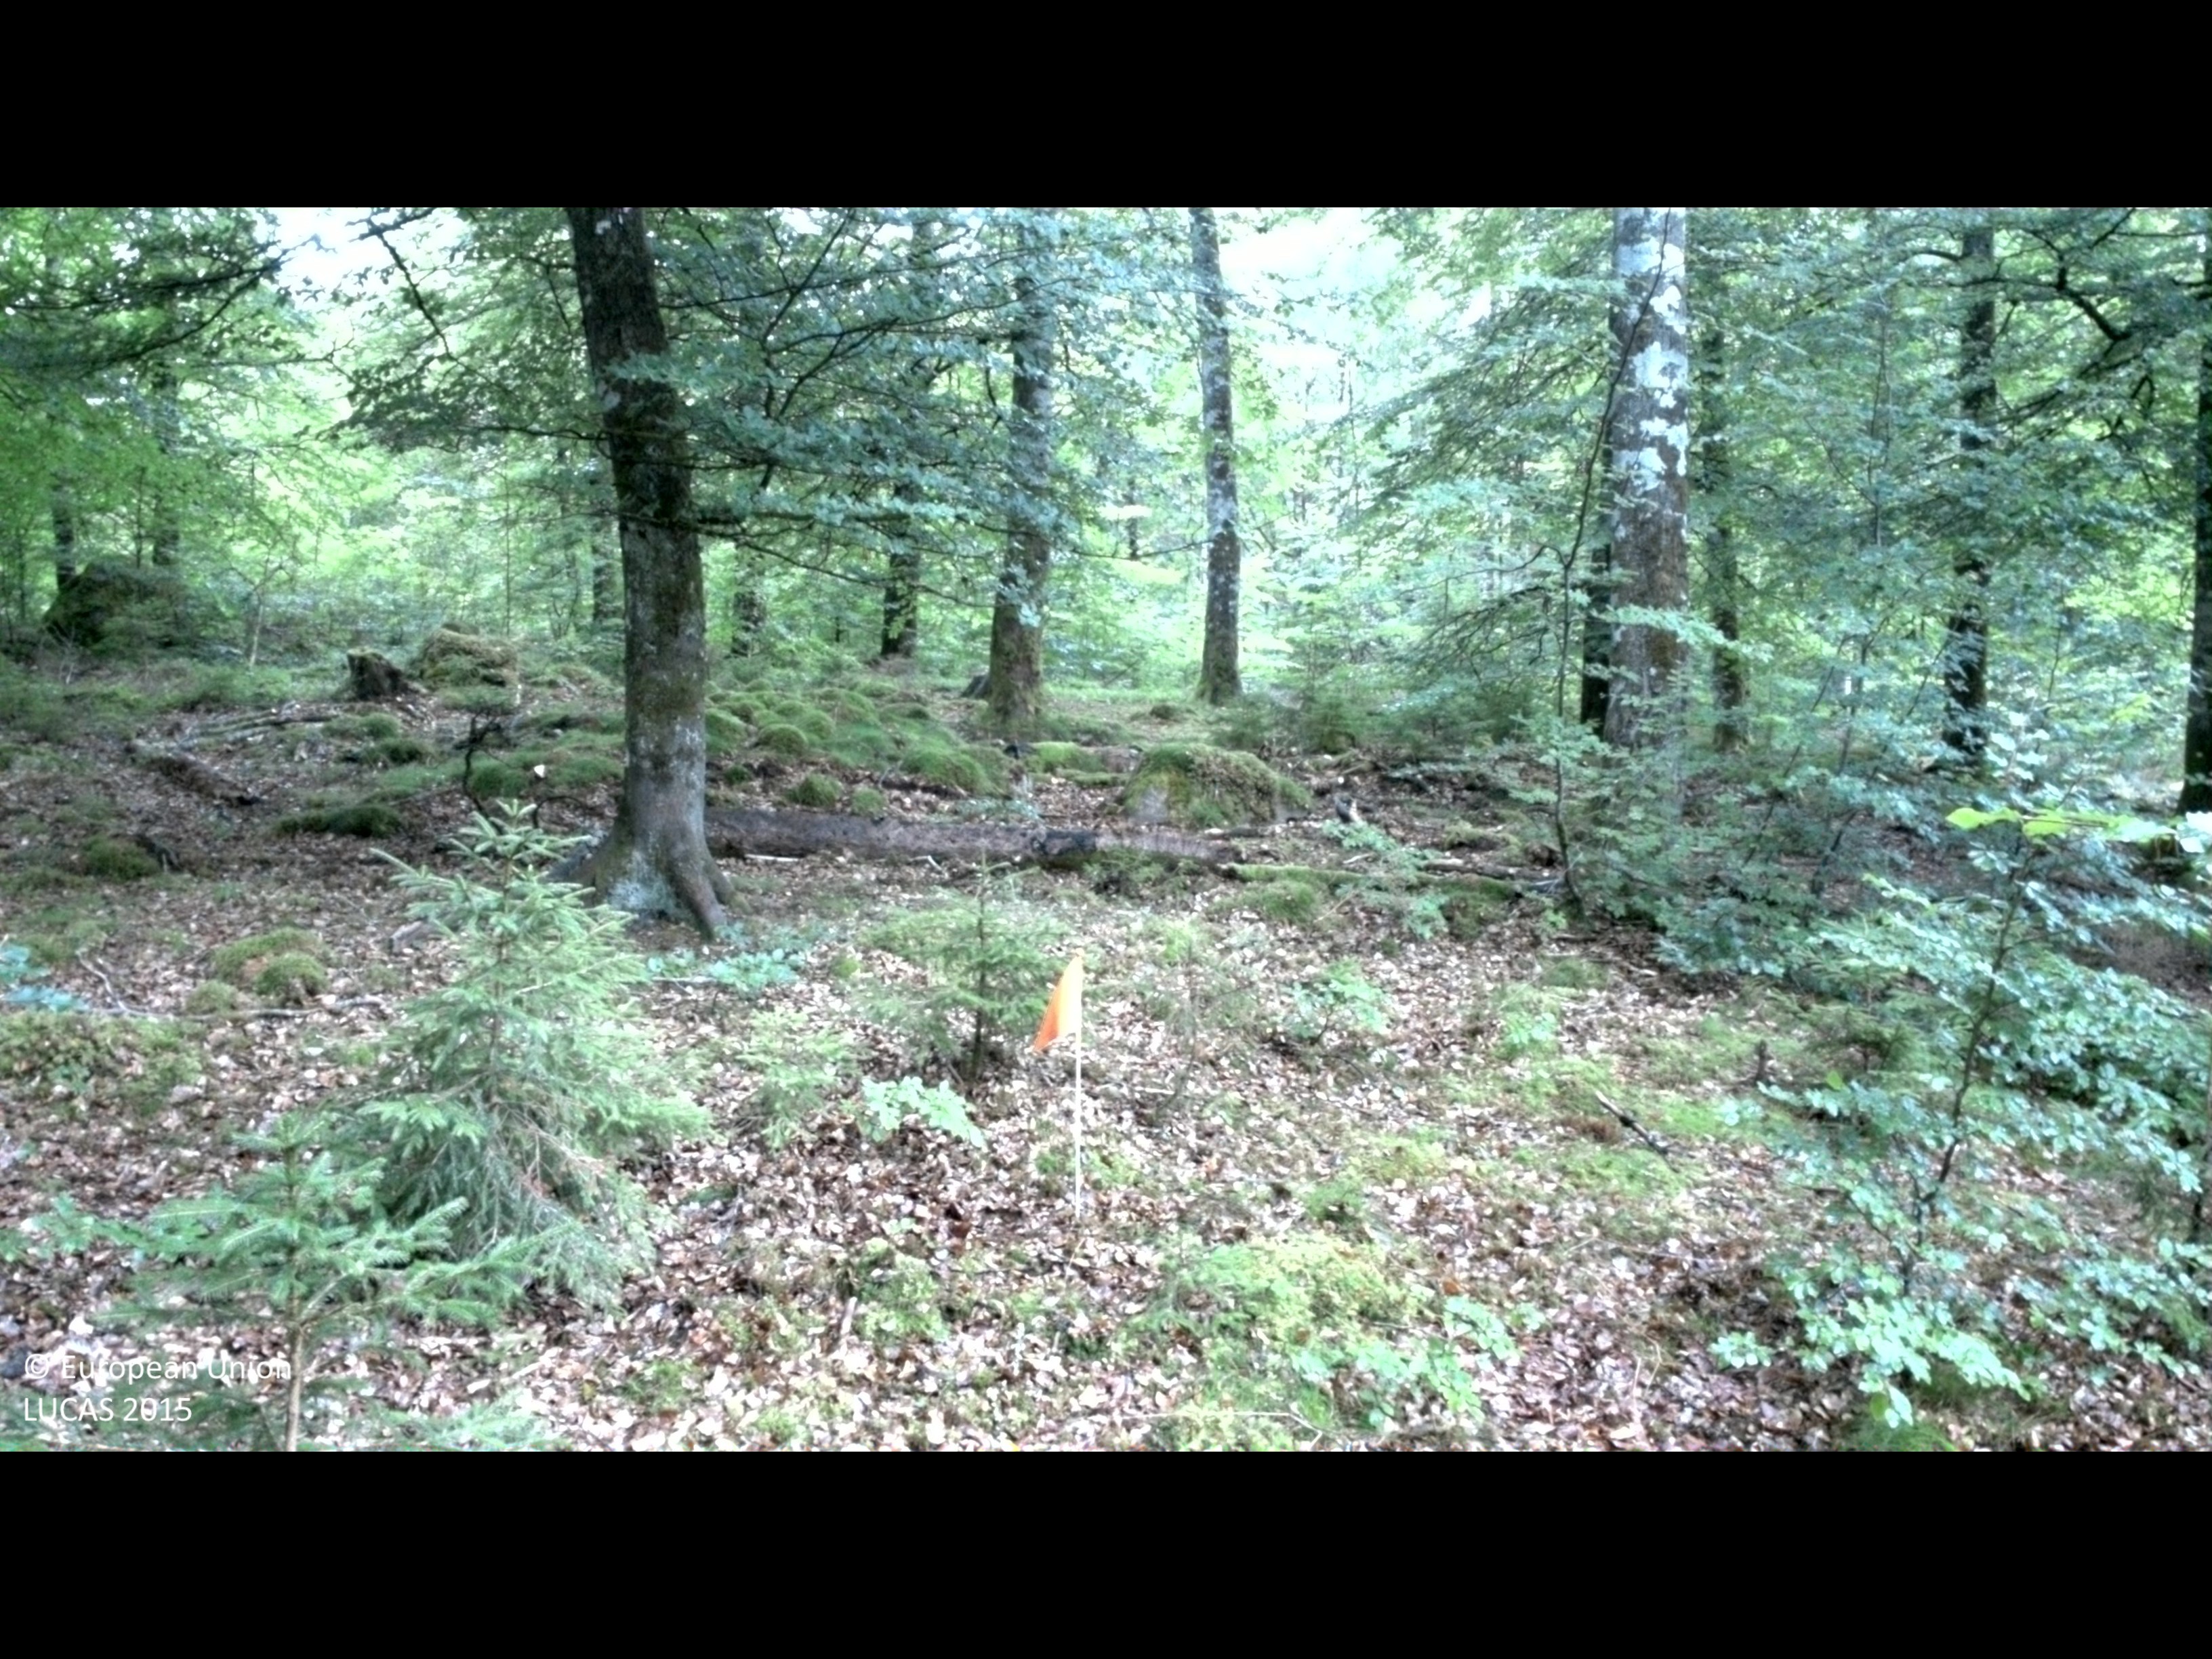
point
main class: Woodland
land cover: Broadleaved woodland
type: beech forest
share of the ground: > 75 %
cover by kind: broadleaved forest trees 75 %, lichens and mosses 5 %
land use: Forestry
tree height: > 5 m
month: August
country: SE
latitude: 57.1372
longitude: 13.8791
